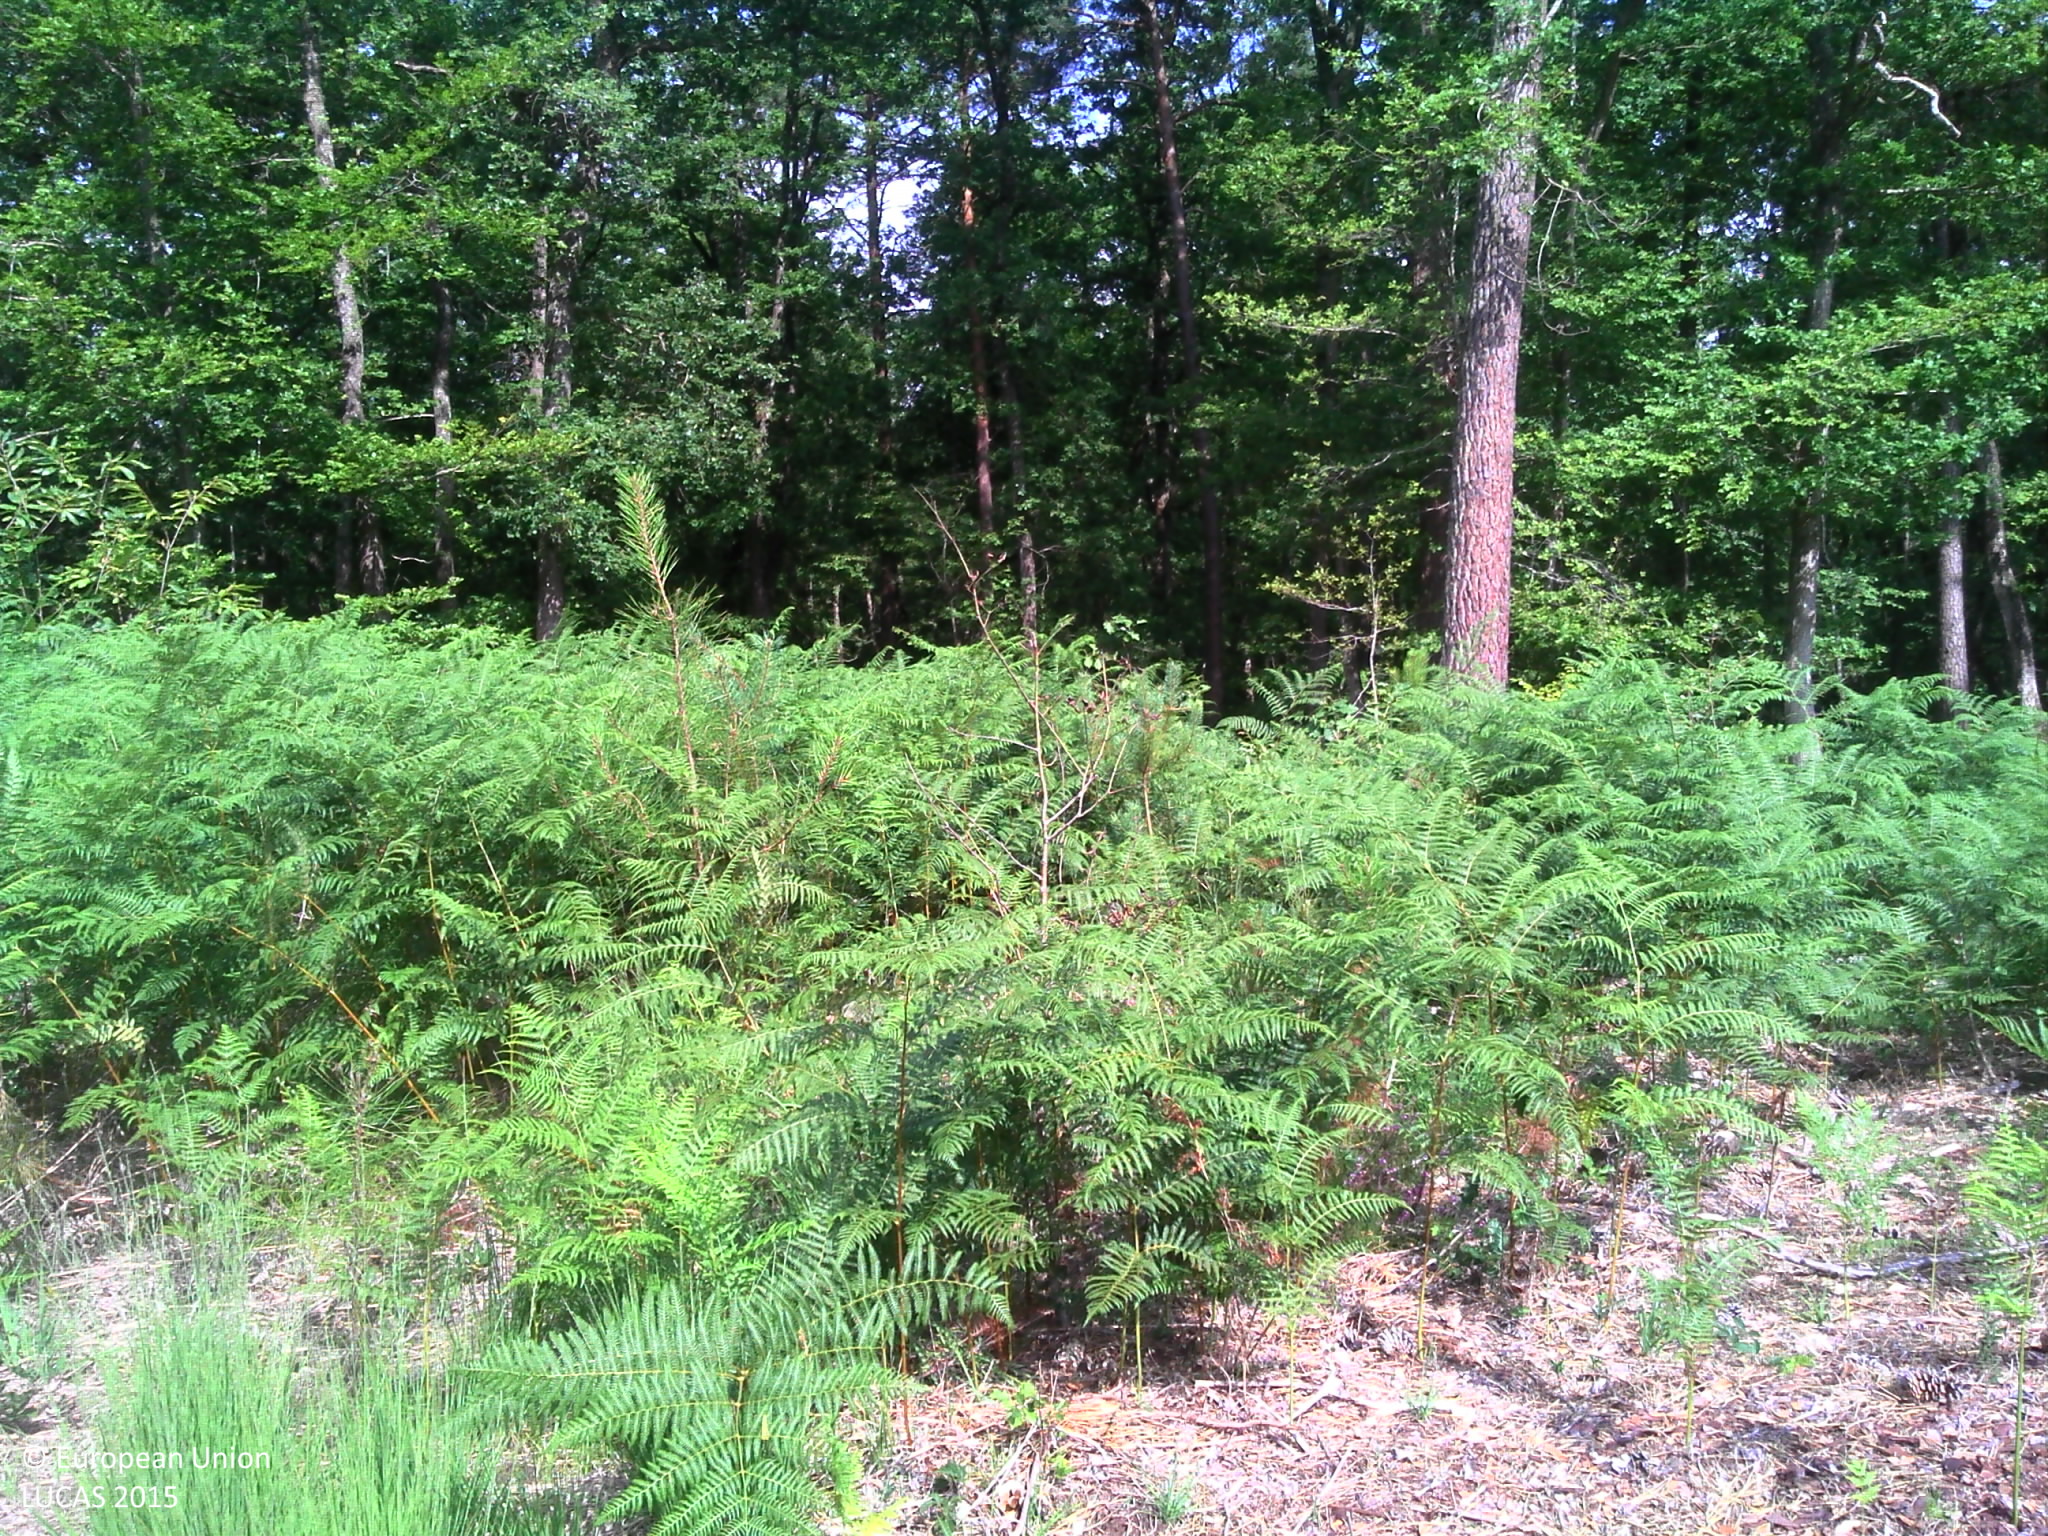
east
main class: Woodland
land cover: Pine dominated mixed woodland
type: exotic forest
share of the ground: > 75 %
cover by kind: coniferous forest trees 40 %, broadleaved forest trees 25 %, shrubs 20 %, herbaceous plants 10 %, lichens and mosses 5 %
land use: Forestry
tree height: < 5 m
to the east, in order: Pine dominated mixed woodland; Tracks; Spontaneously vegetated surfaces; Pine dominated mixed woodland; Tracks; Pine dominated mixed woodland; Broadleaved woodland; Tracks; Pine dominated mixed woodland; Tracks; Pine dominated mixed woodland
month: July
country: FR
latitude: 47.2396
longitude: 0.3747
